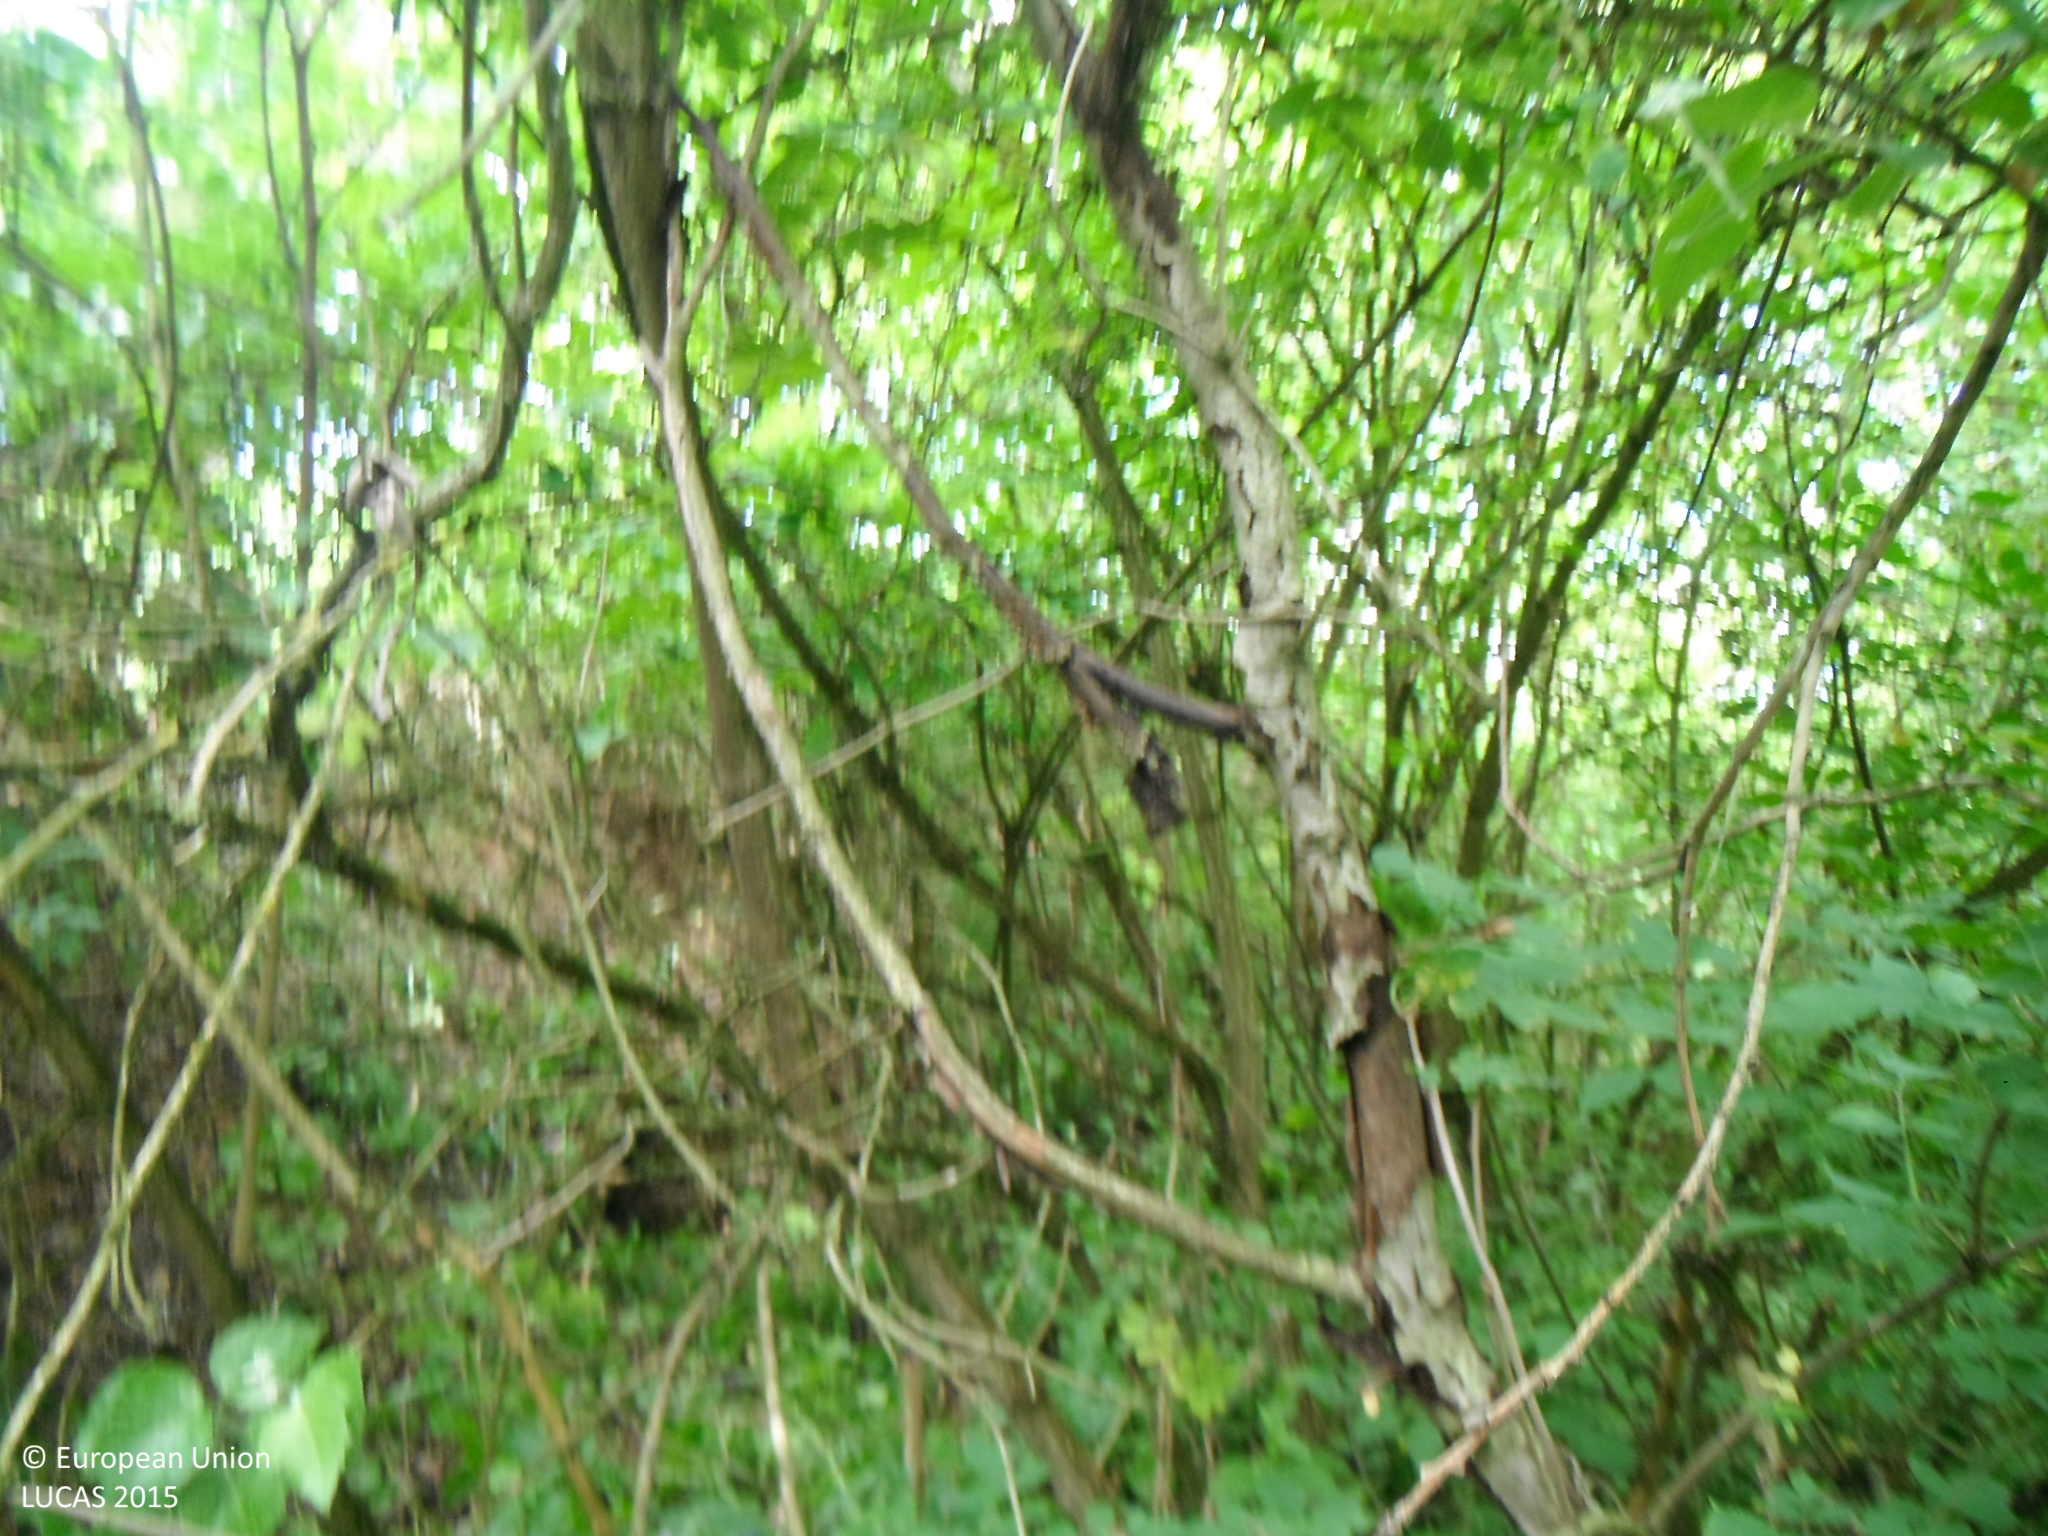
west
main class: Woodland
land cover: Broadleaved woodland
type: mesophytic deciduous forest
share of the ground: 50 - 75 %
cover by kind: broadleaved forest trees 55 %, shrubs 45 %
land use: Semi-natural and natural areas not in use
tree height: > 5 m
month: June
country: SK
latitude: 47.9165
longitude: 18.2160
